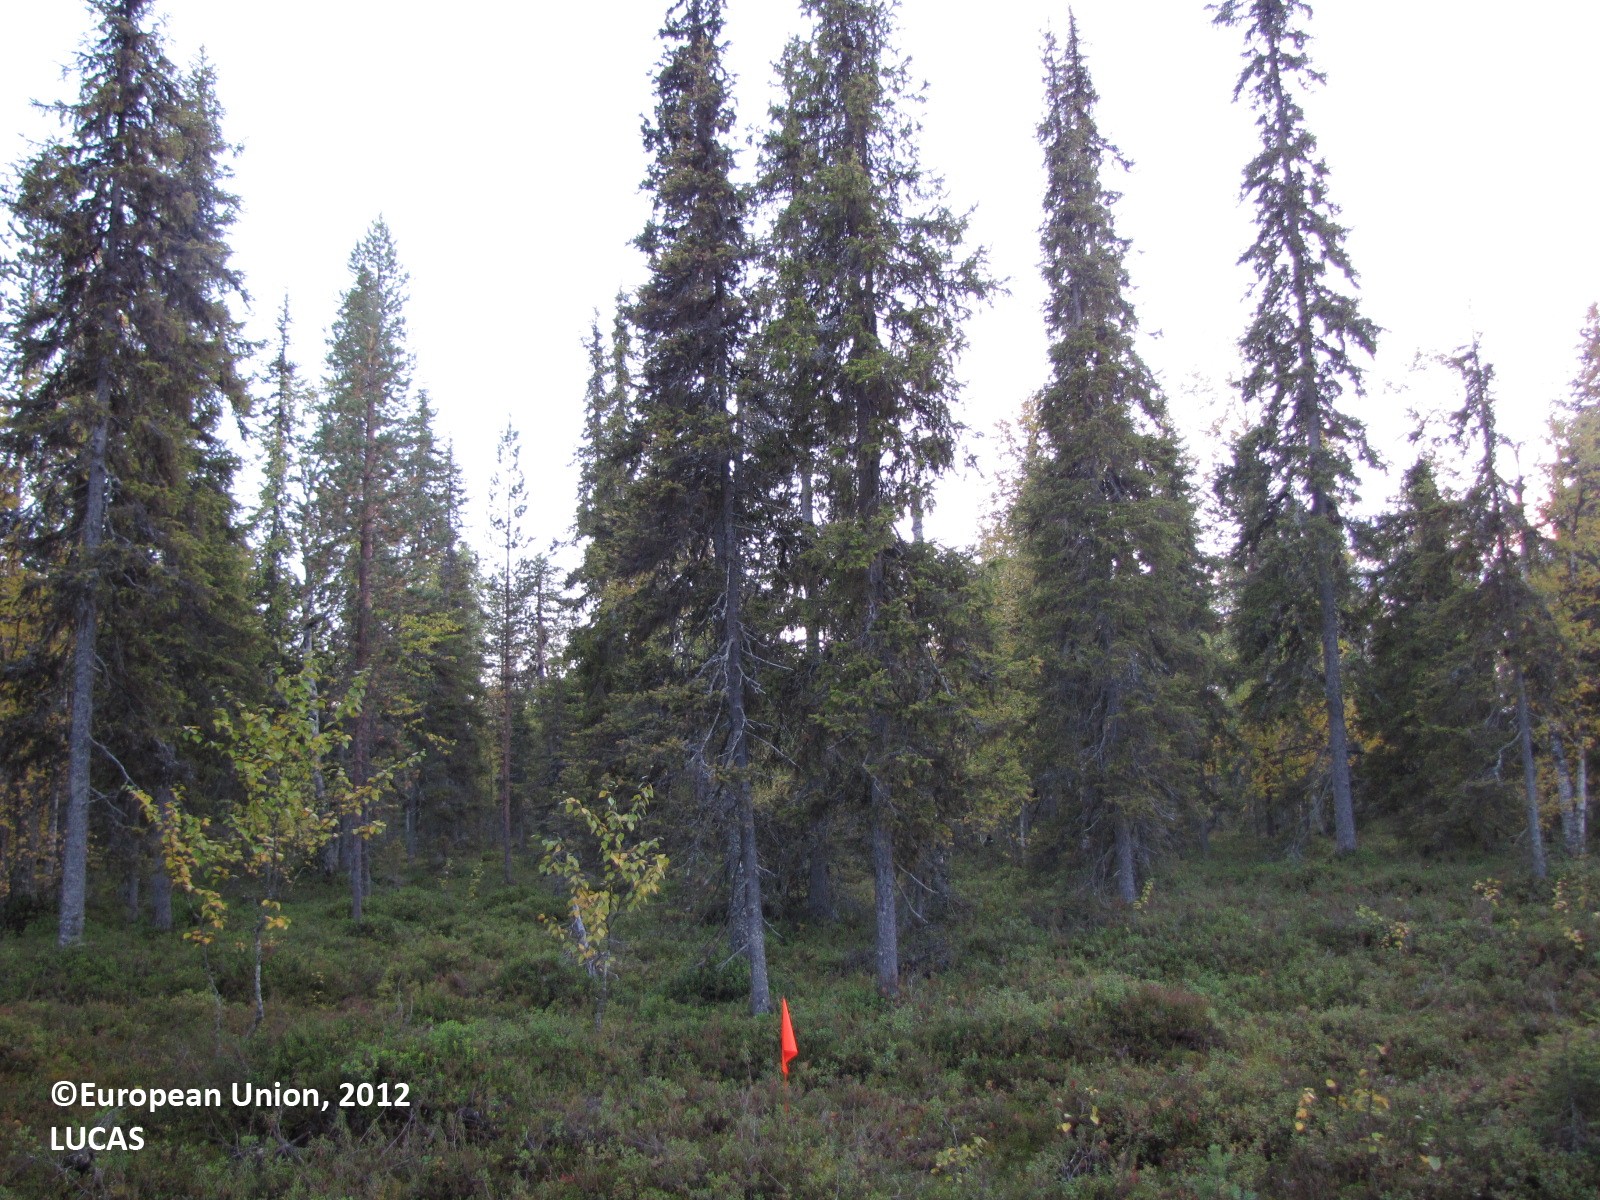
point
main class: Woodland
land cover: Spruce dominated coniferous woodland
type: boreal forest
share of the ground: 25 - 50 %
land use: Forestry
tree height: > 5 m
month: September
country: FI
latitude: 67.3665
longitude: 25.3467
